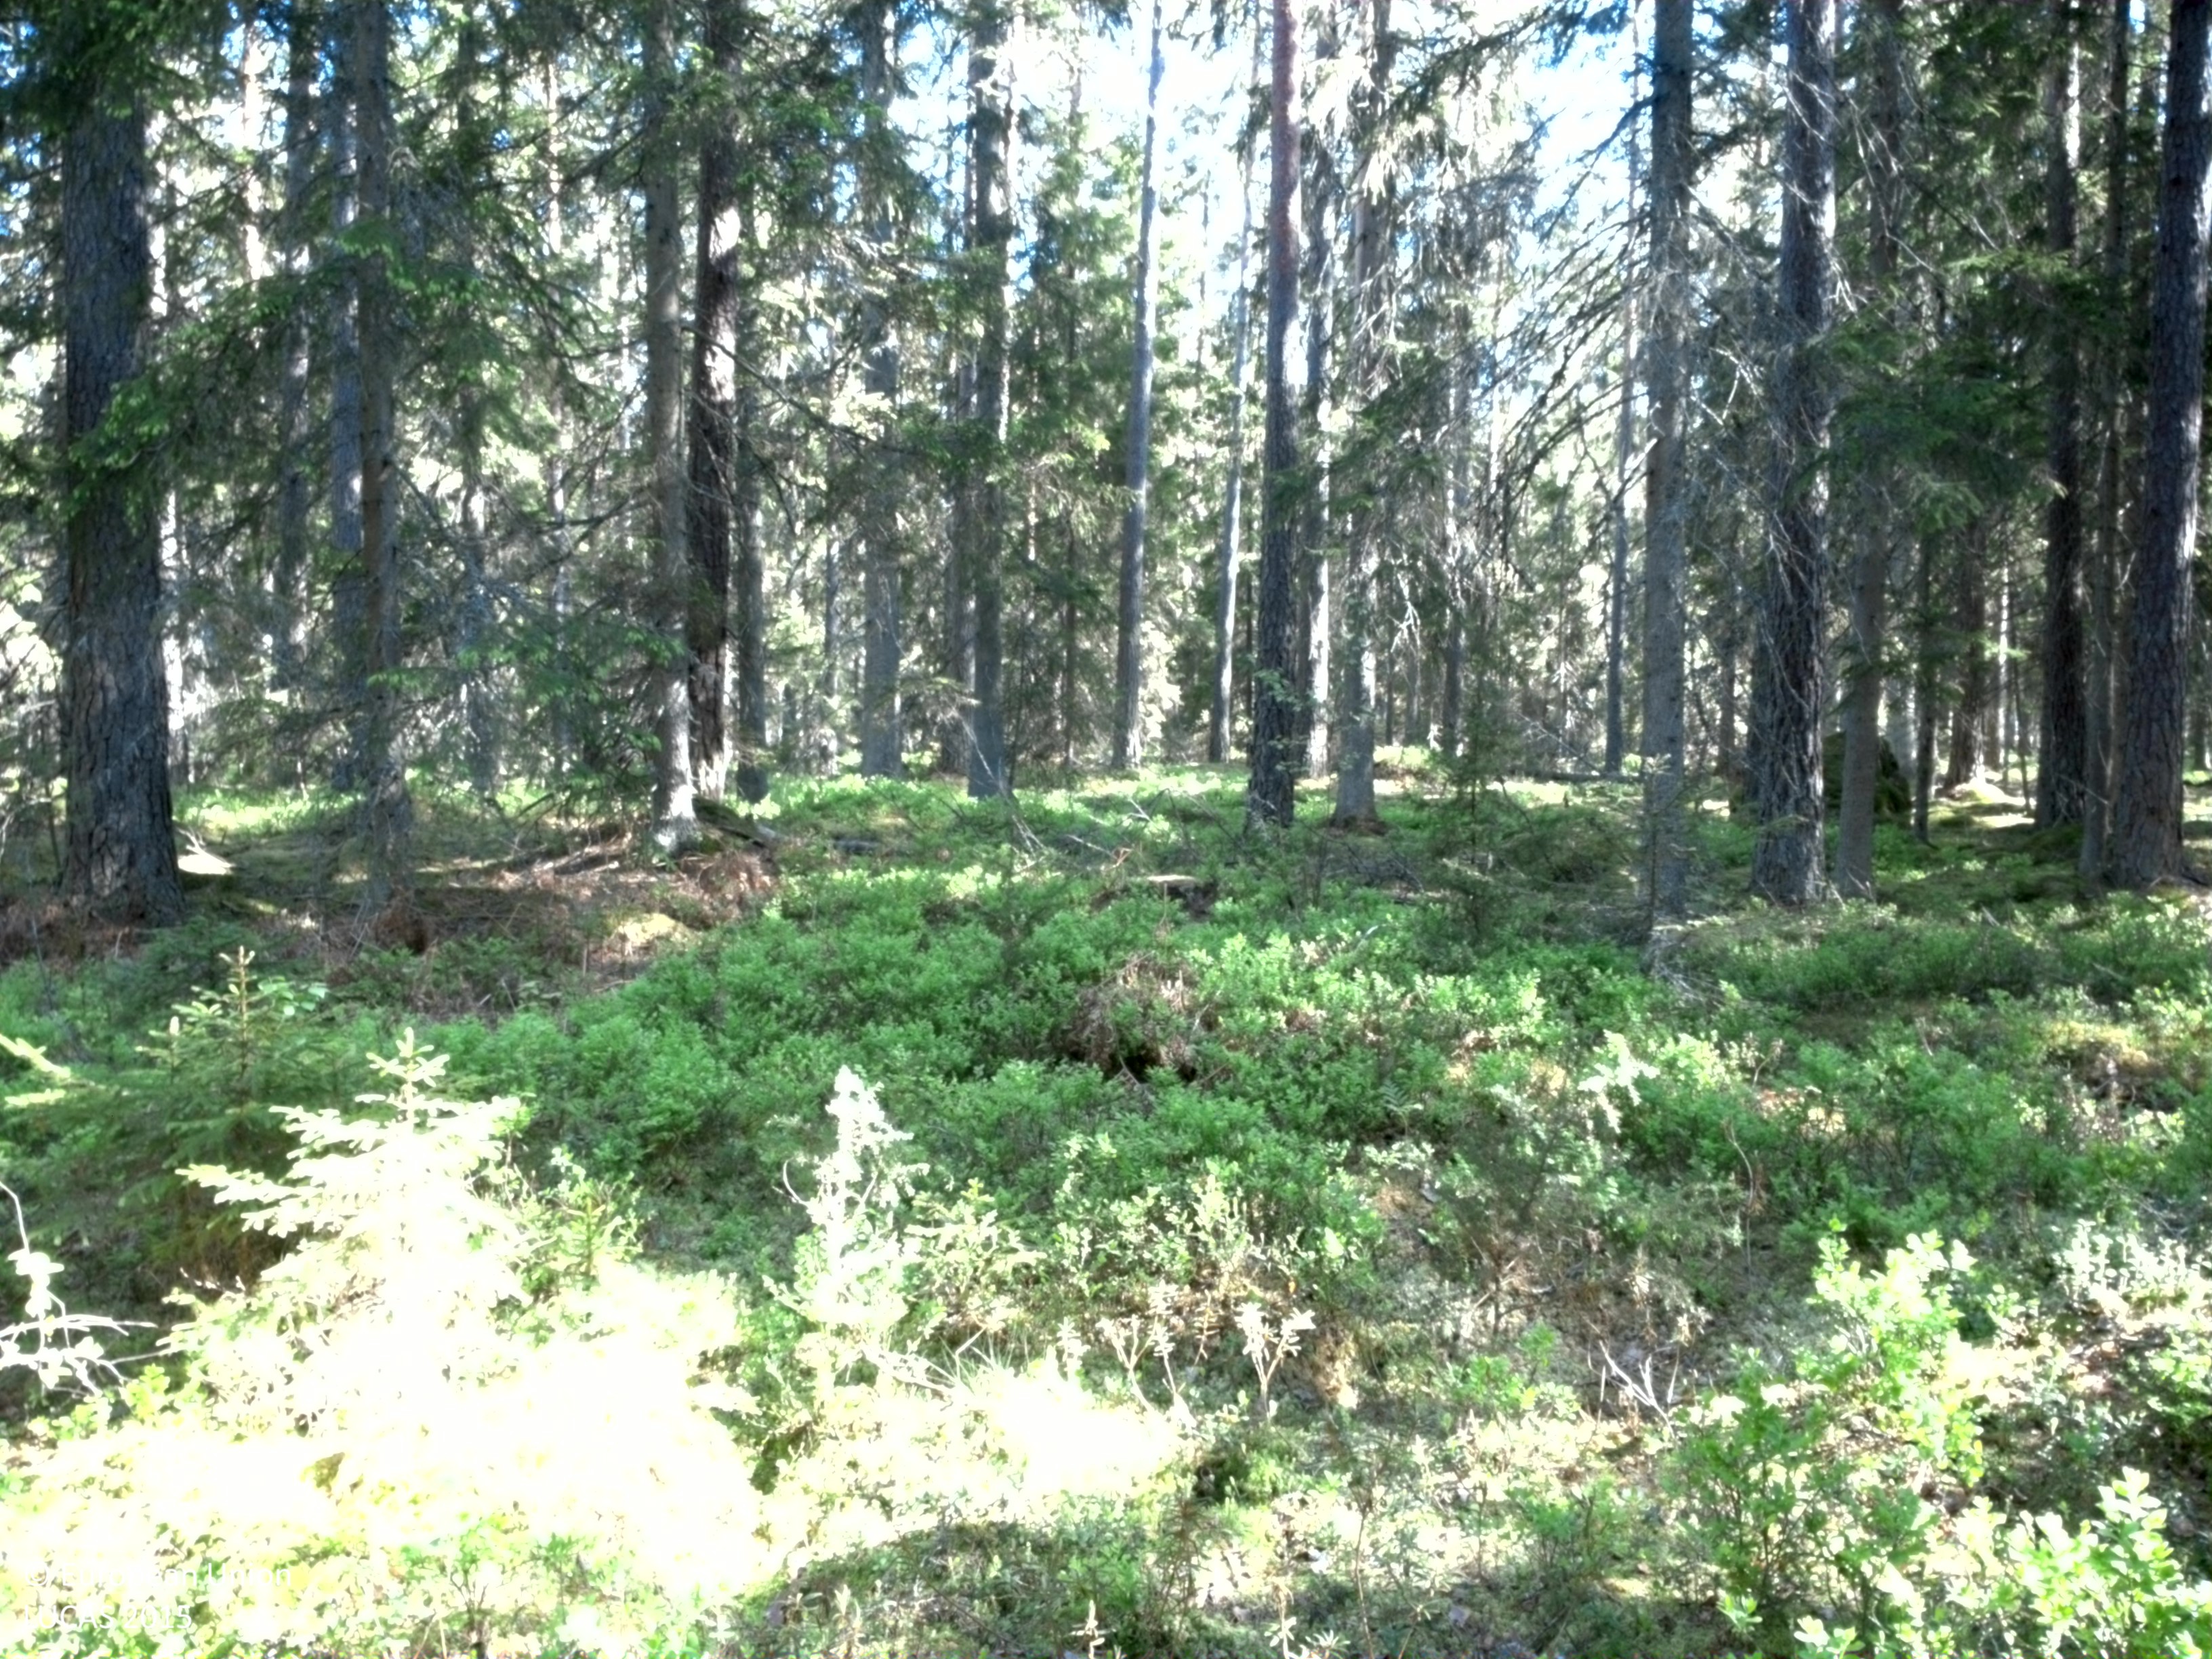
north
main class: Woodland
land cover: Spruce dominated coniferous woodland
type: boreal forest
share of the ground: 50 - 75 %
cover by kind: coniferous forest trees 40 %, shrubs 30 %, lichens and mosses 20 %, broadleaved forest trees 10 %
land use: Forestry
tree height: > 5 m
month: May
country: SE
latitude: 57.3849
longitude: 15.9366
